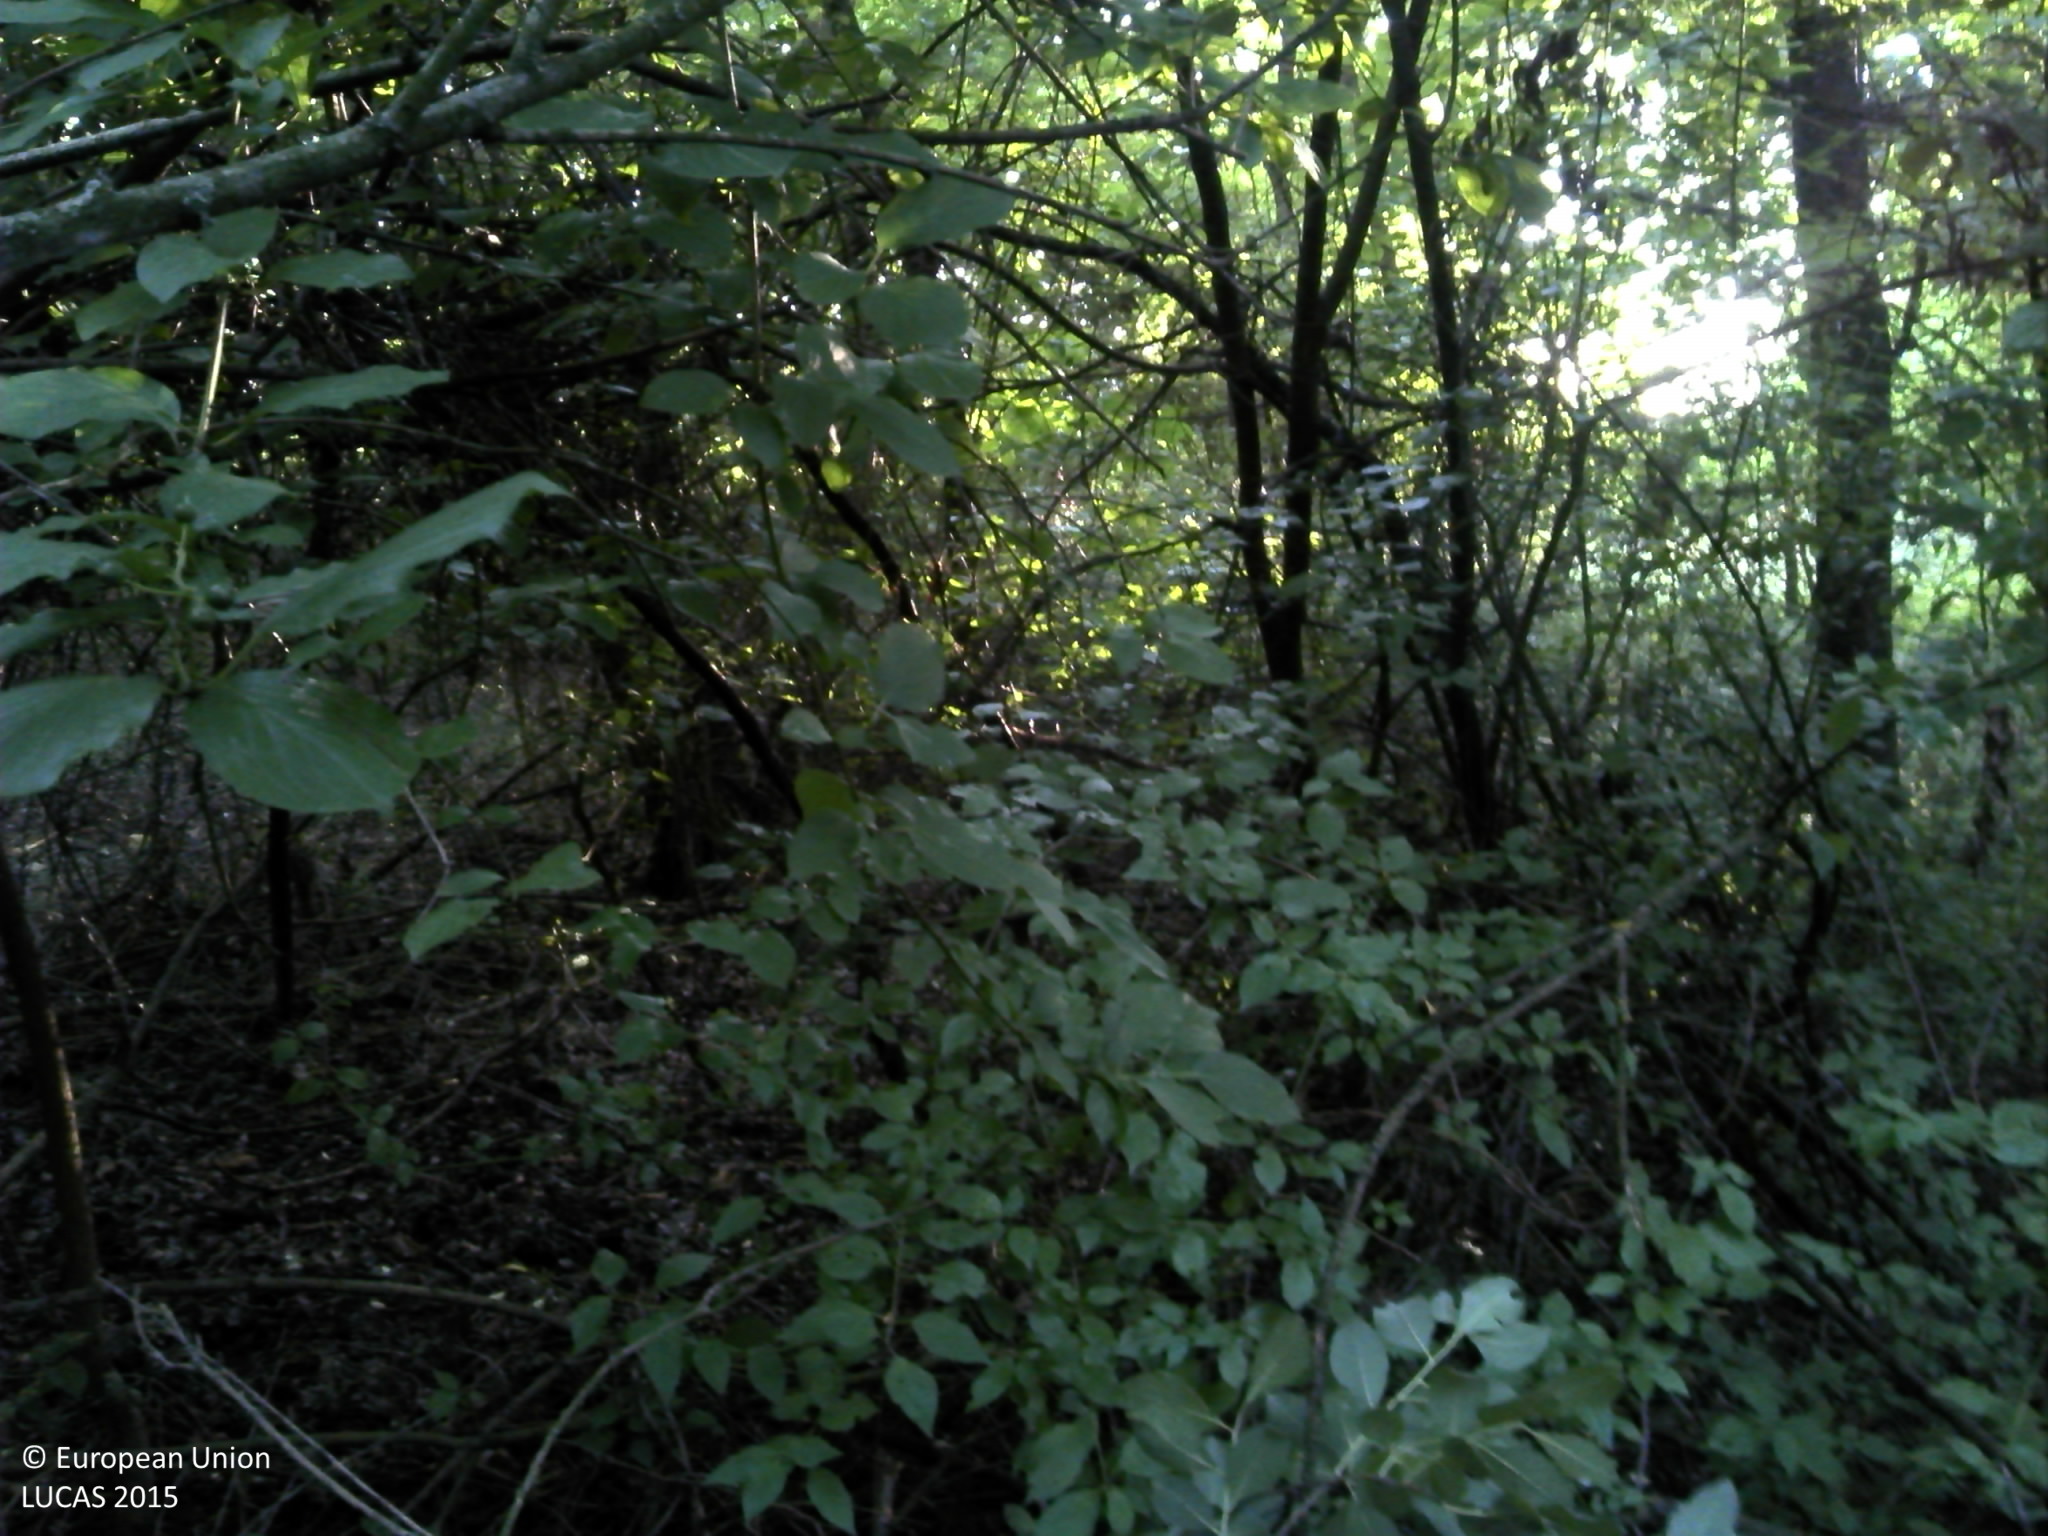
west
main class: Woodland
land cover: Broadleaved woodland
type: mesophytic deciduous forest
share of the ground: > 75 %
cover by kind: broadleaved forest trees 100 %
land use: Semi-natural and natural areas not in use
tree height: > 5 m
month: June
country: HR
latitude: 45.4364
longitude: 18.4556
